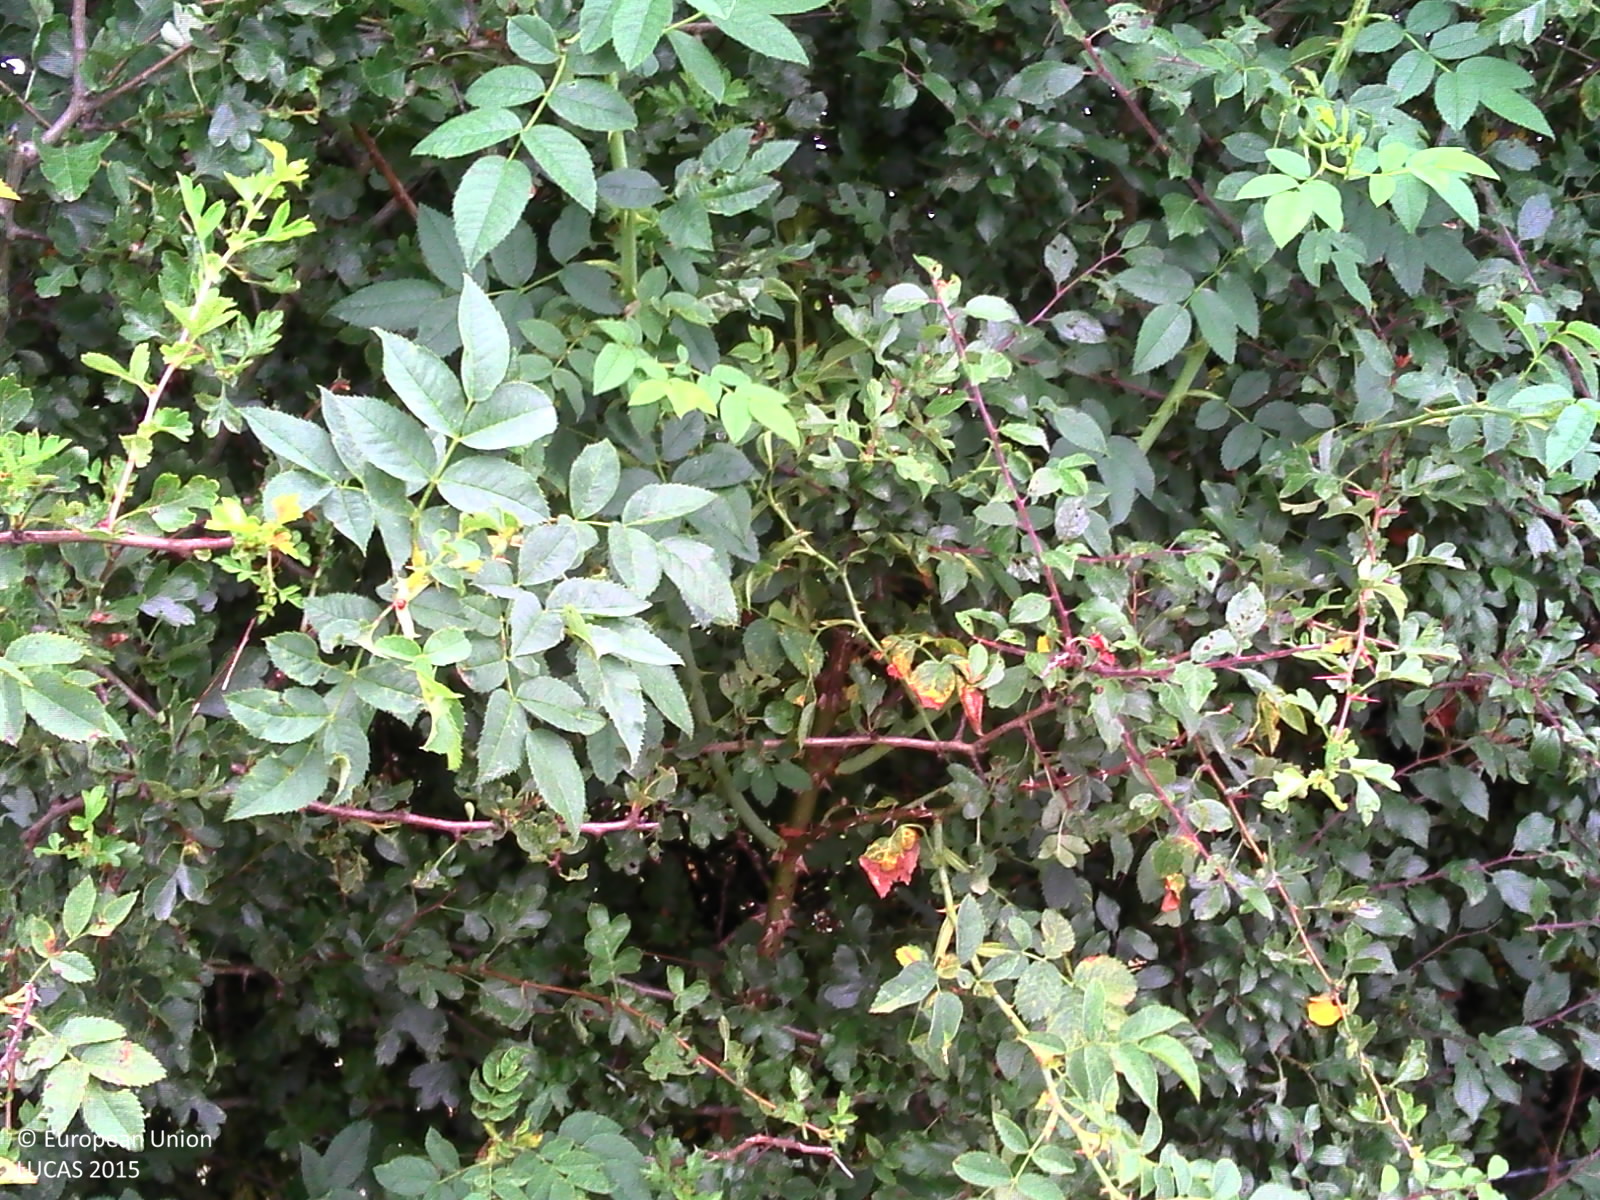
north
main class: Grassland
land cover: Grassland without tree/shrub cover
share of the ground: > 75 %
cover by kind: herbaceous plants 100 %
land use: Agriculture (excluding fallow land and kitchen gardens)
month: July
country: BE
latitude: 50.1840
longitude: 4.6325
